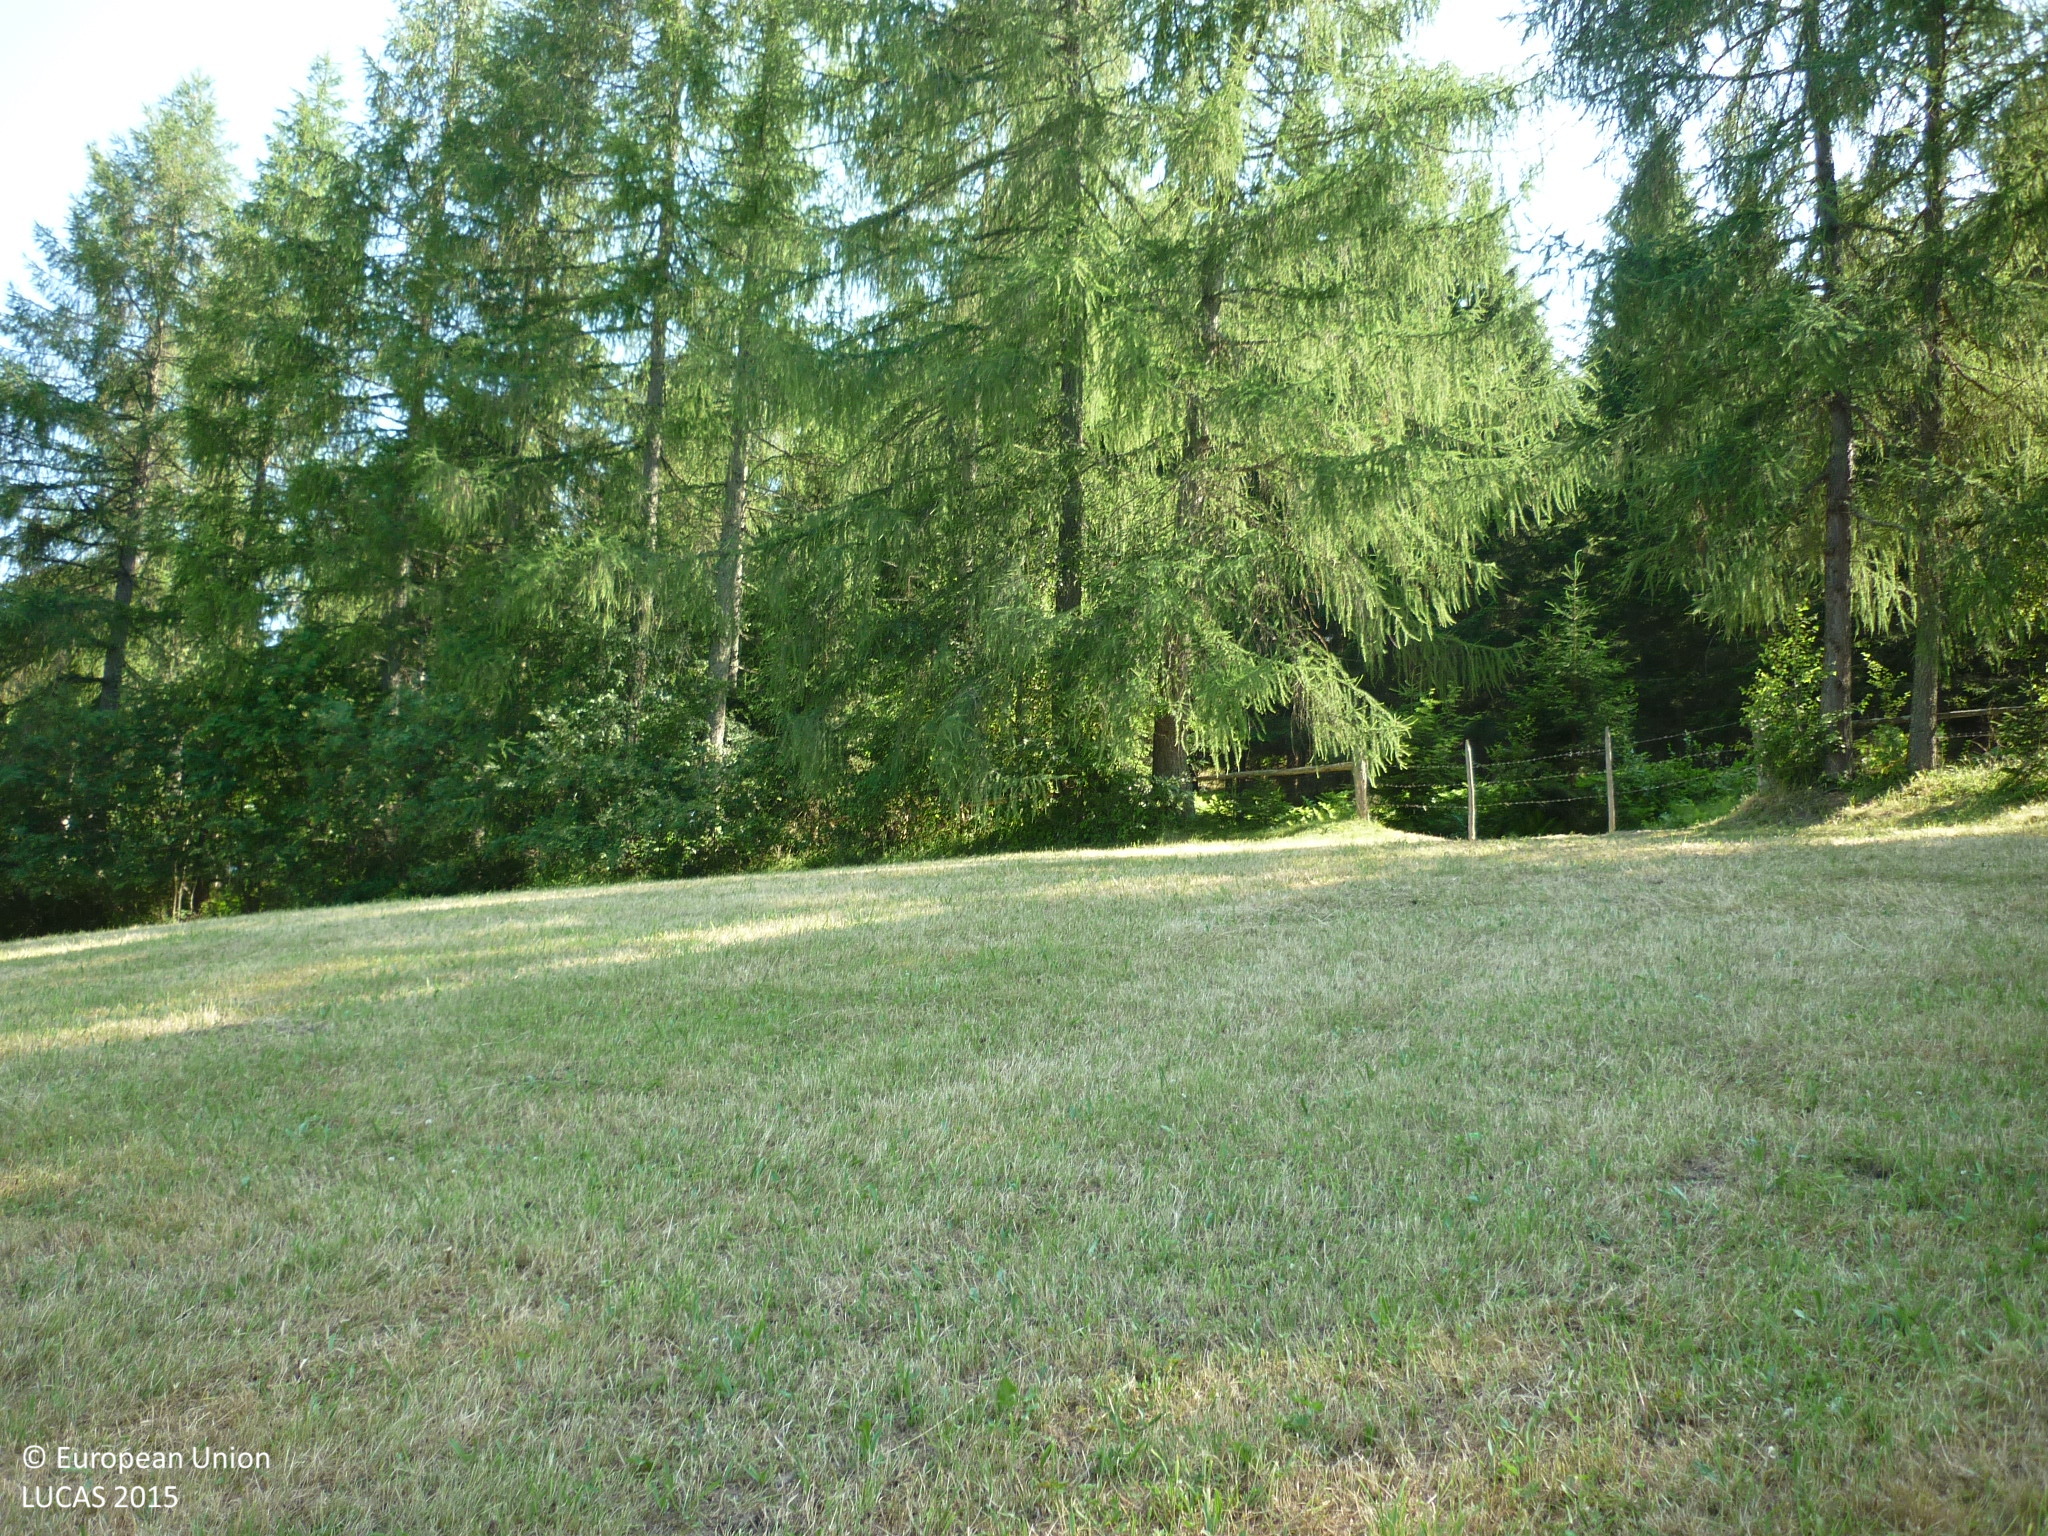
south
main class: Grassland
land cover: Grassland without tree/shrub cover
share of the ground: > 75 %
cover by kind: herbaceous plants 100 %
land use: Agriculture (excluding fallow land and kitchen gardens)
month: July
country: AT
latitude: 47.1170
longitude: 14.6248
